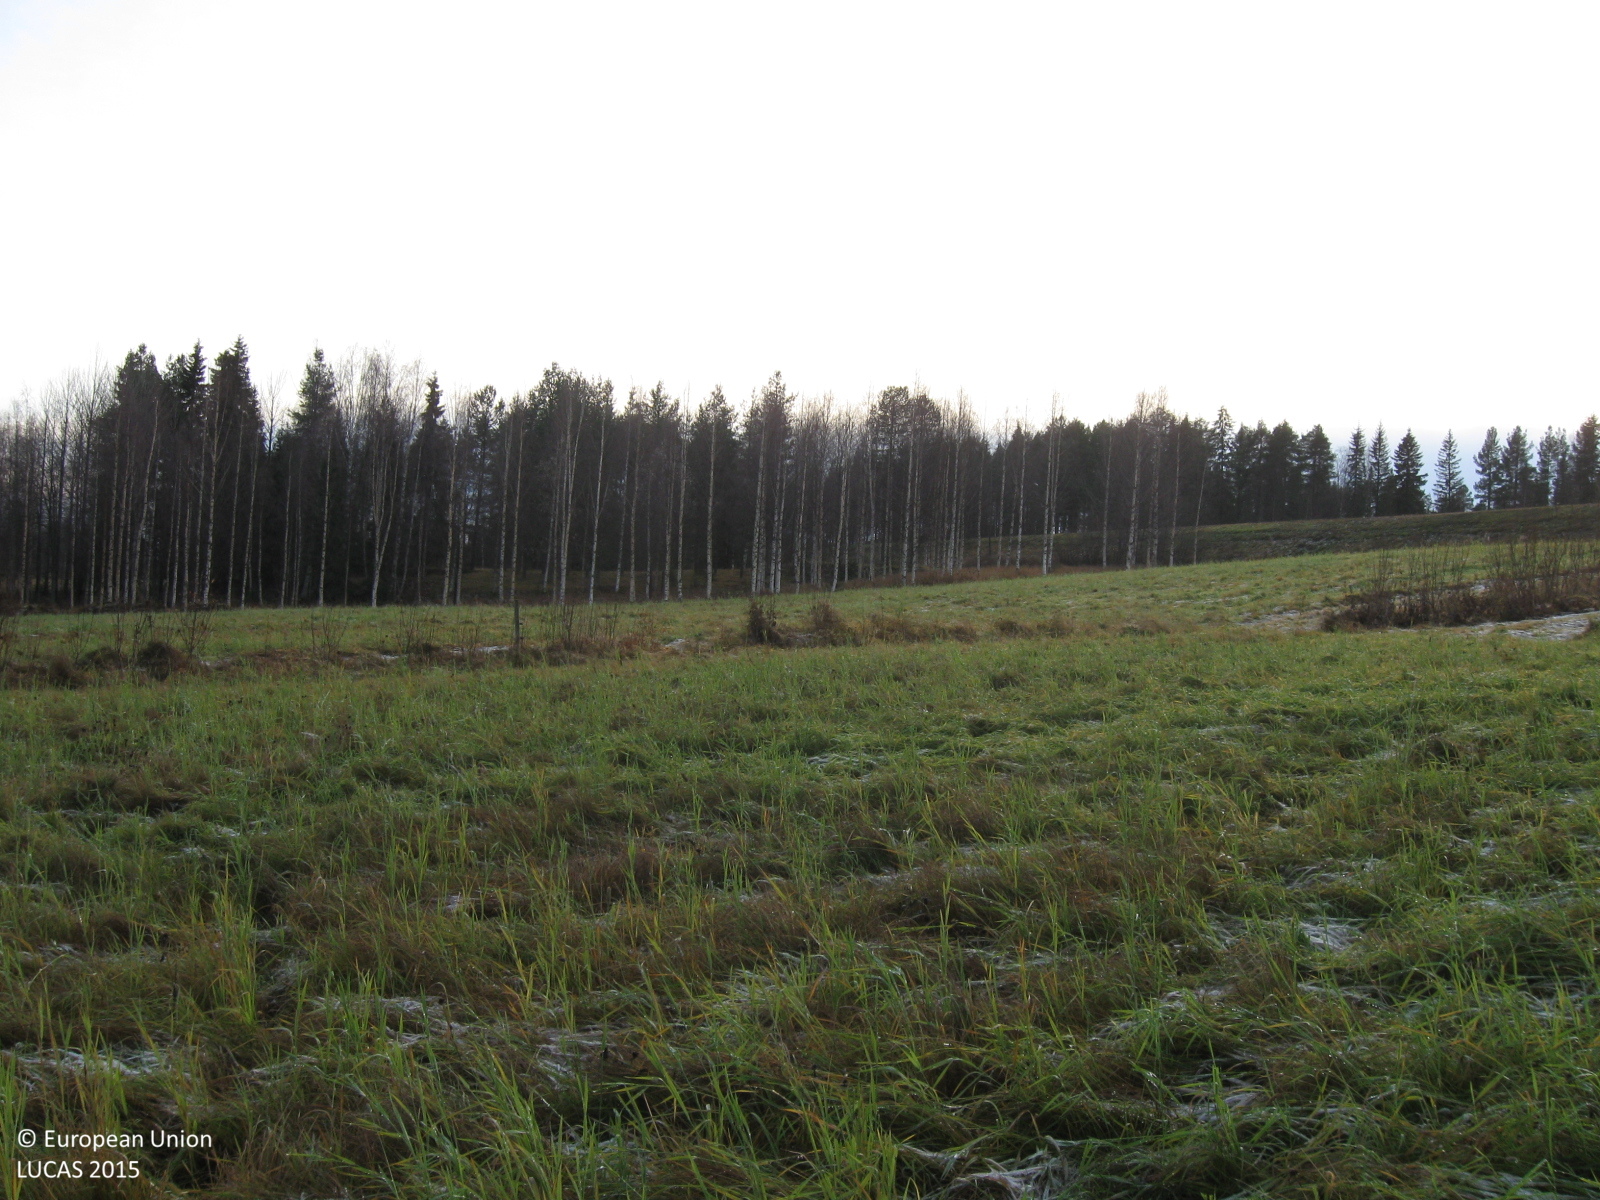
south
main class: Grassland
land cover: Grassland without tree/shrub cover
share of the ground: > 75 %
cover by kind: herbaceous plants 100 %
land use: Agriculture (excluding fallow land and kitchen gardens)
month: October
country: SE
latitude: 66.2944
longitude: 20.8157
